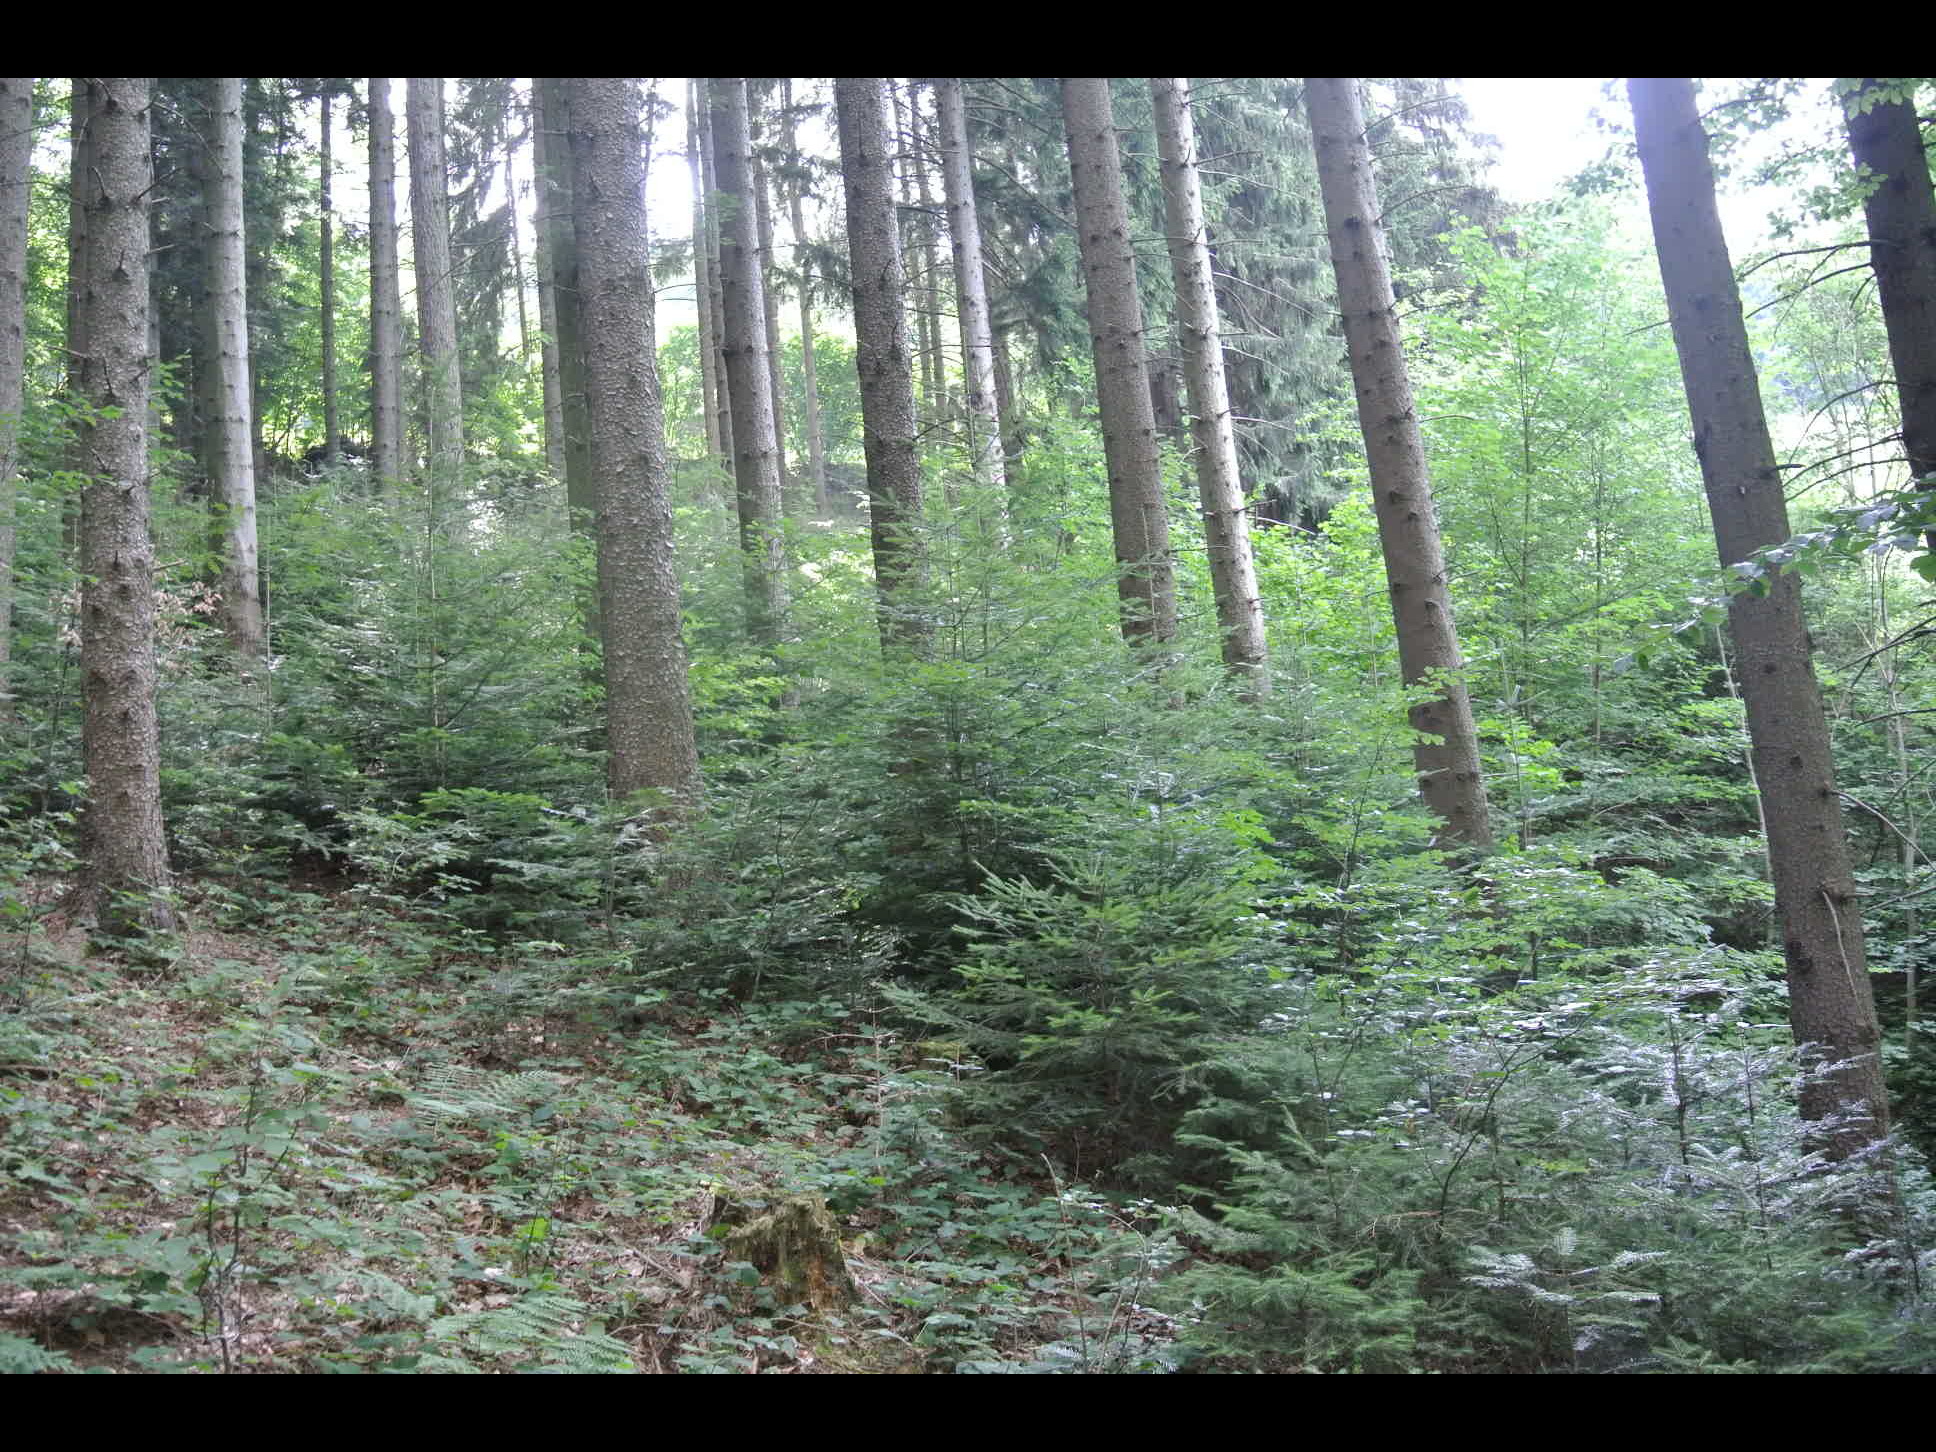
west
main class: Woodland
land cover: Spruce dominated coniferous woodland
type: alpine coniferous forest
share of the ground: > 75 %
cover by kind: coniferous forest trees 70 %, broadleaved forest trees 20 %, herbaceous plants 10 %
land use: Forestry
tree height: > 5 m
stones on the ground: < 10 %
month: July
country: AT
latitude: 47.5656
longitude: 16.1302
